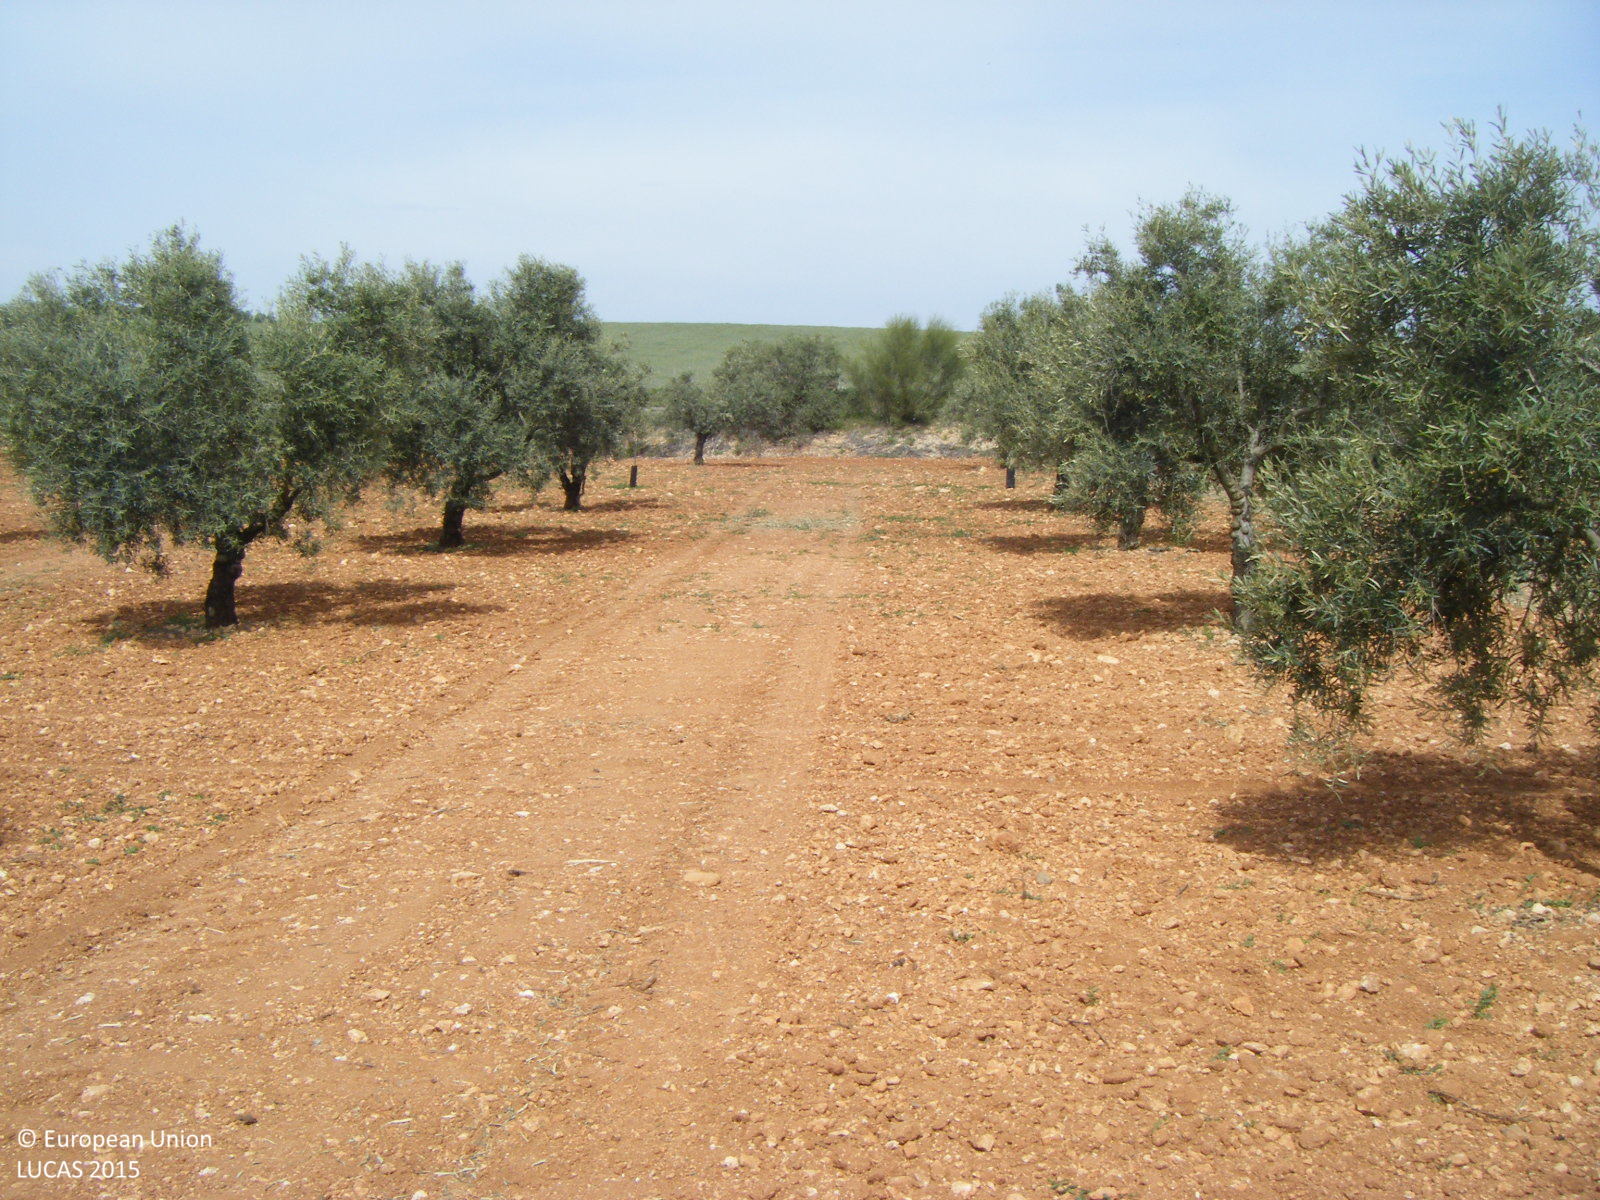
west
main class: Cropland
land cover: Olive groves
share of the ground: 10 - 25 %
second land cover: Other bare soil
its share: > 75 %
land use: Agriculture (excluding fallow land and kitchen gardens)
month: April
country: ES
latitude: 37.1052
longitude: -4.7527
